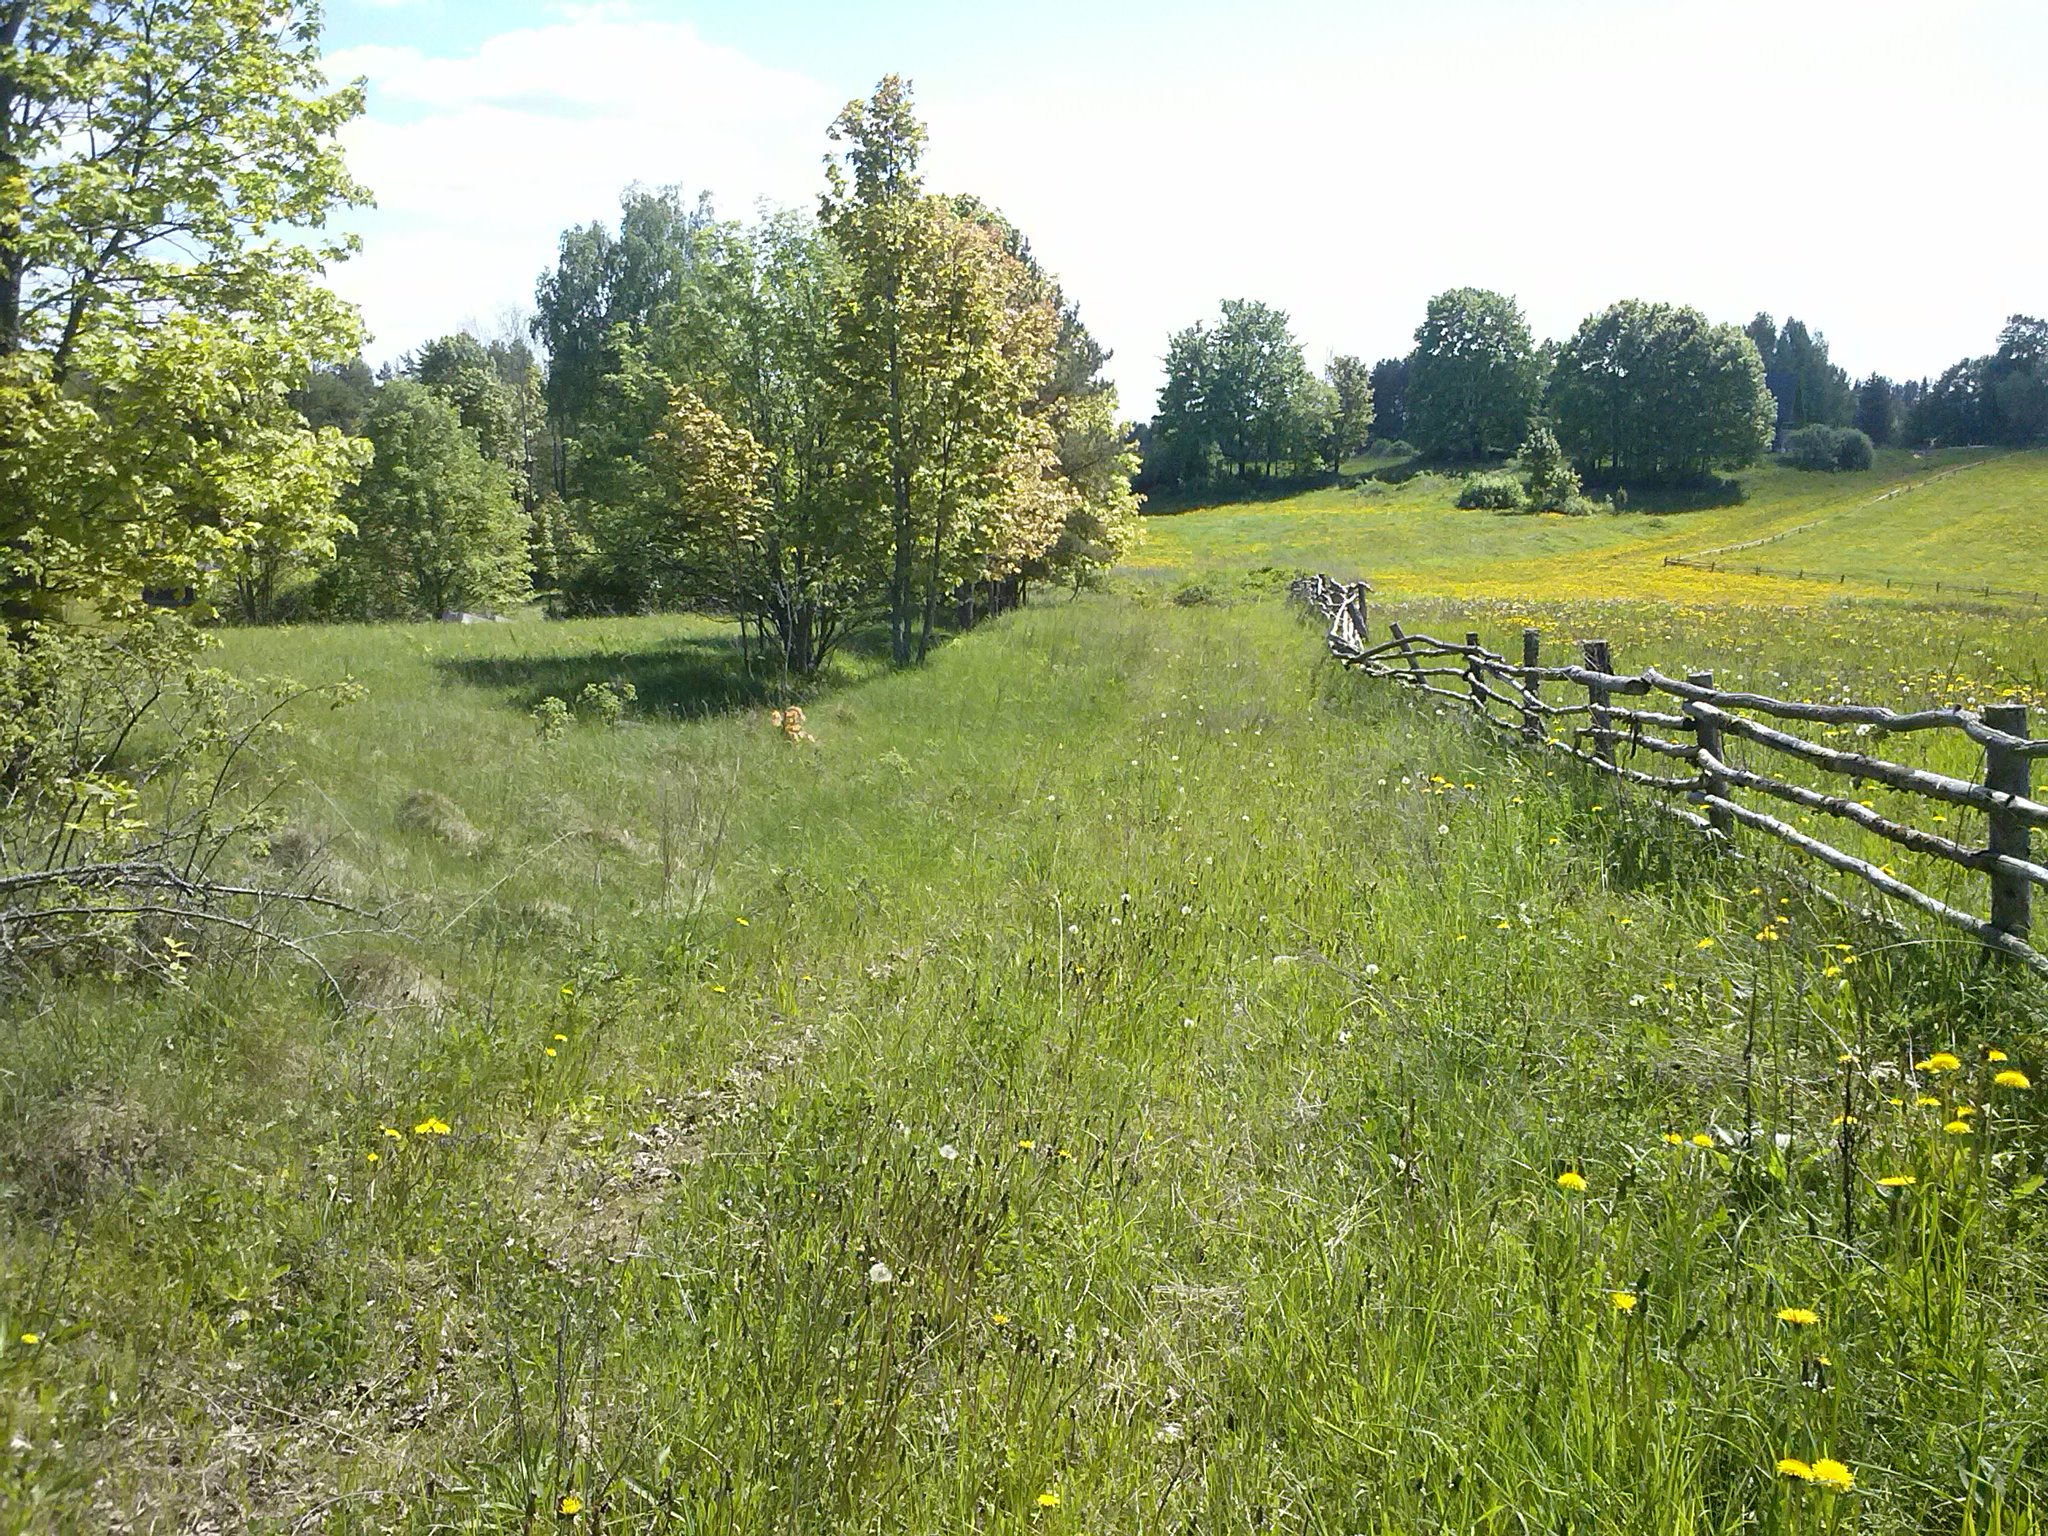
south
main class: Grassland
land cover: Grassland without tree/shrub cover
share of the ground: > 75 %
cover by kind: herbaceous plants 100 %
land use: Agriculture (excluding fallow land and kitchen gardens)
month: May
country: LV
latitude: 56.1969
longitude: 27.5733
